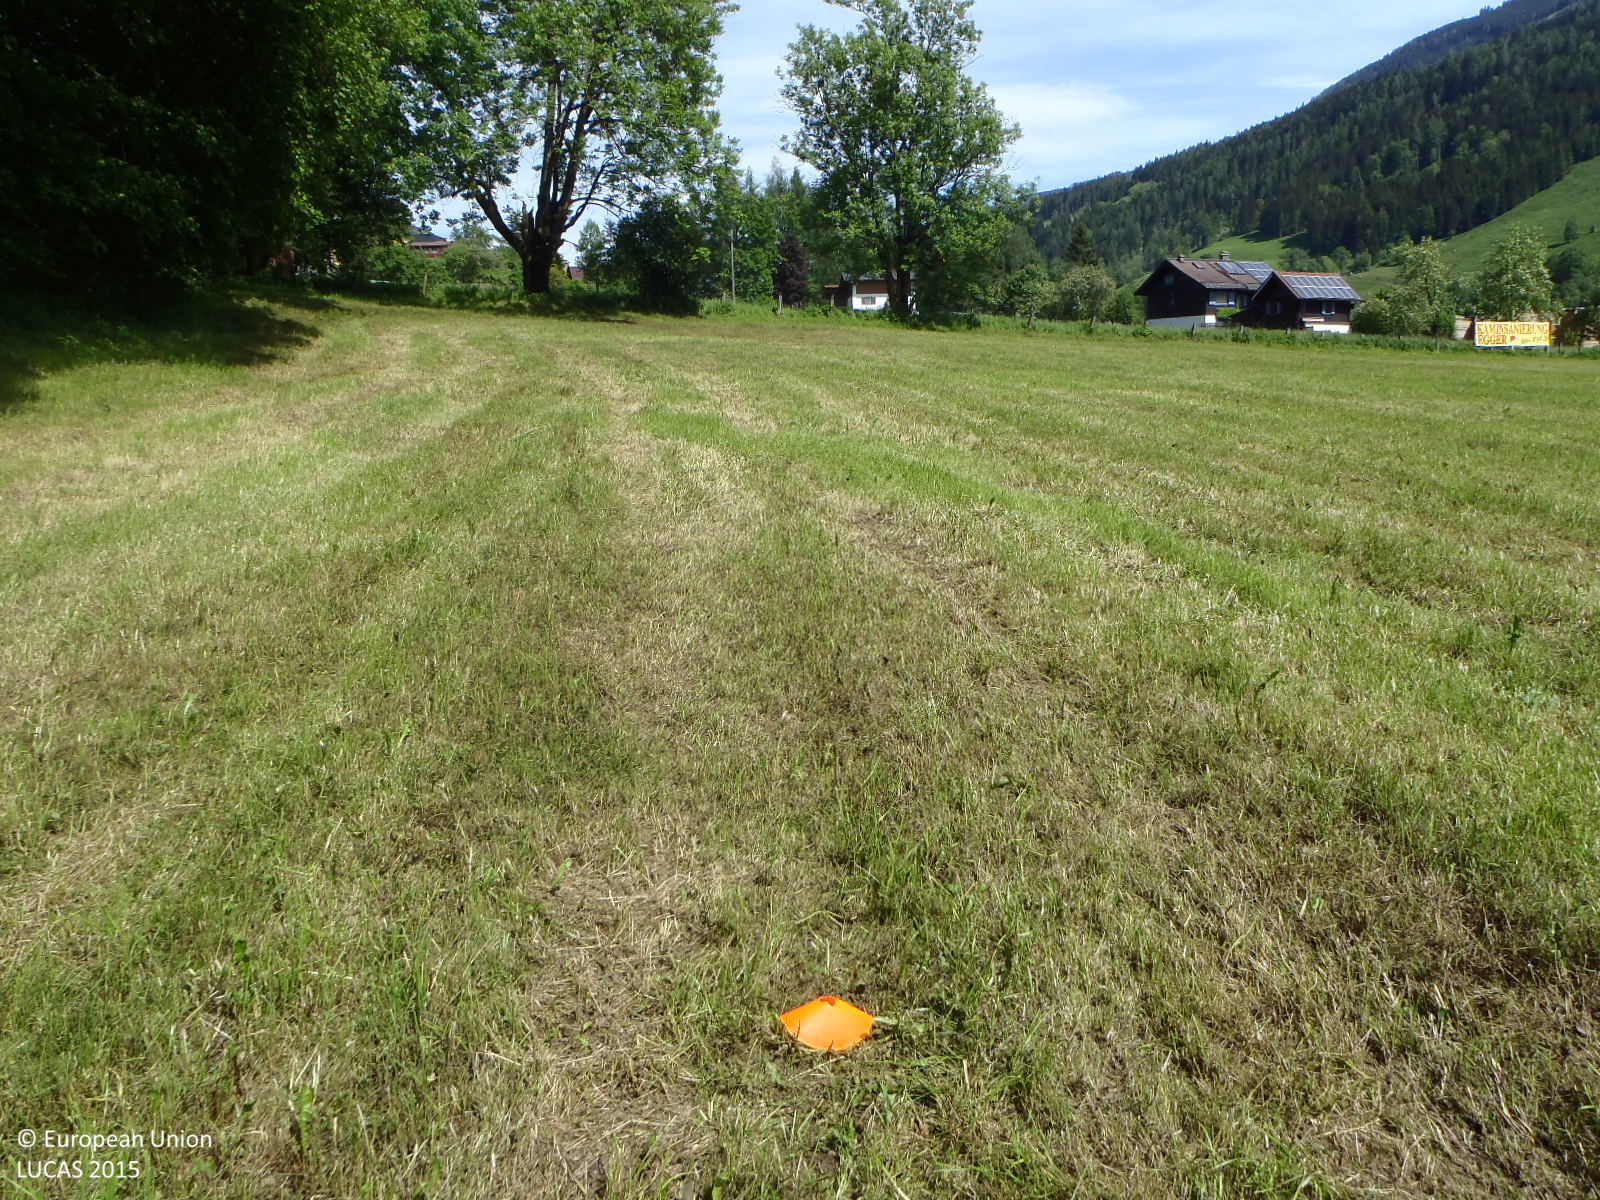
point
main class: Grassland
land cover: Grassland without tree/shrub cover
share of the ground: > 75 %
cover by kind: herbaceous plants 80 %, unconsolidated bare surface 20 %
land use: Agriculture (excluding fallow land and kitchen gardens)
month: May
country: AT
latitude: 47.2858
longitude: 12.8671
